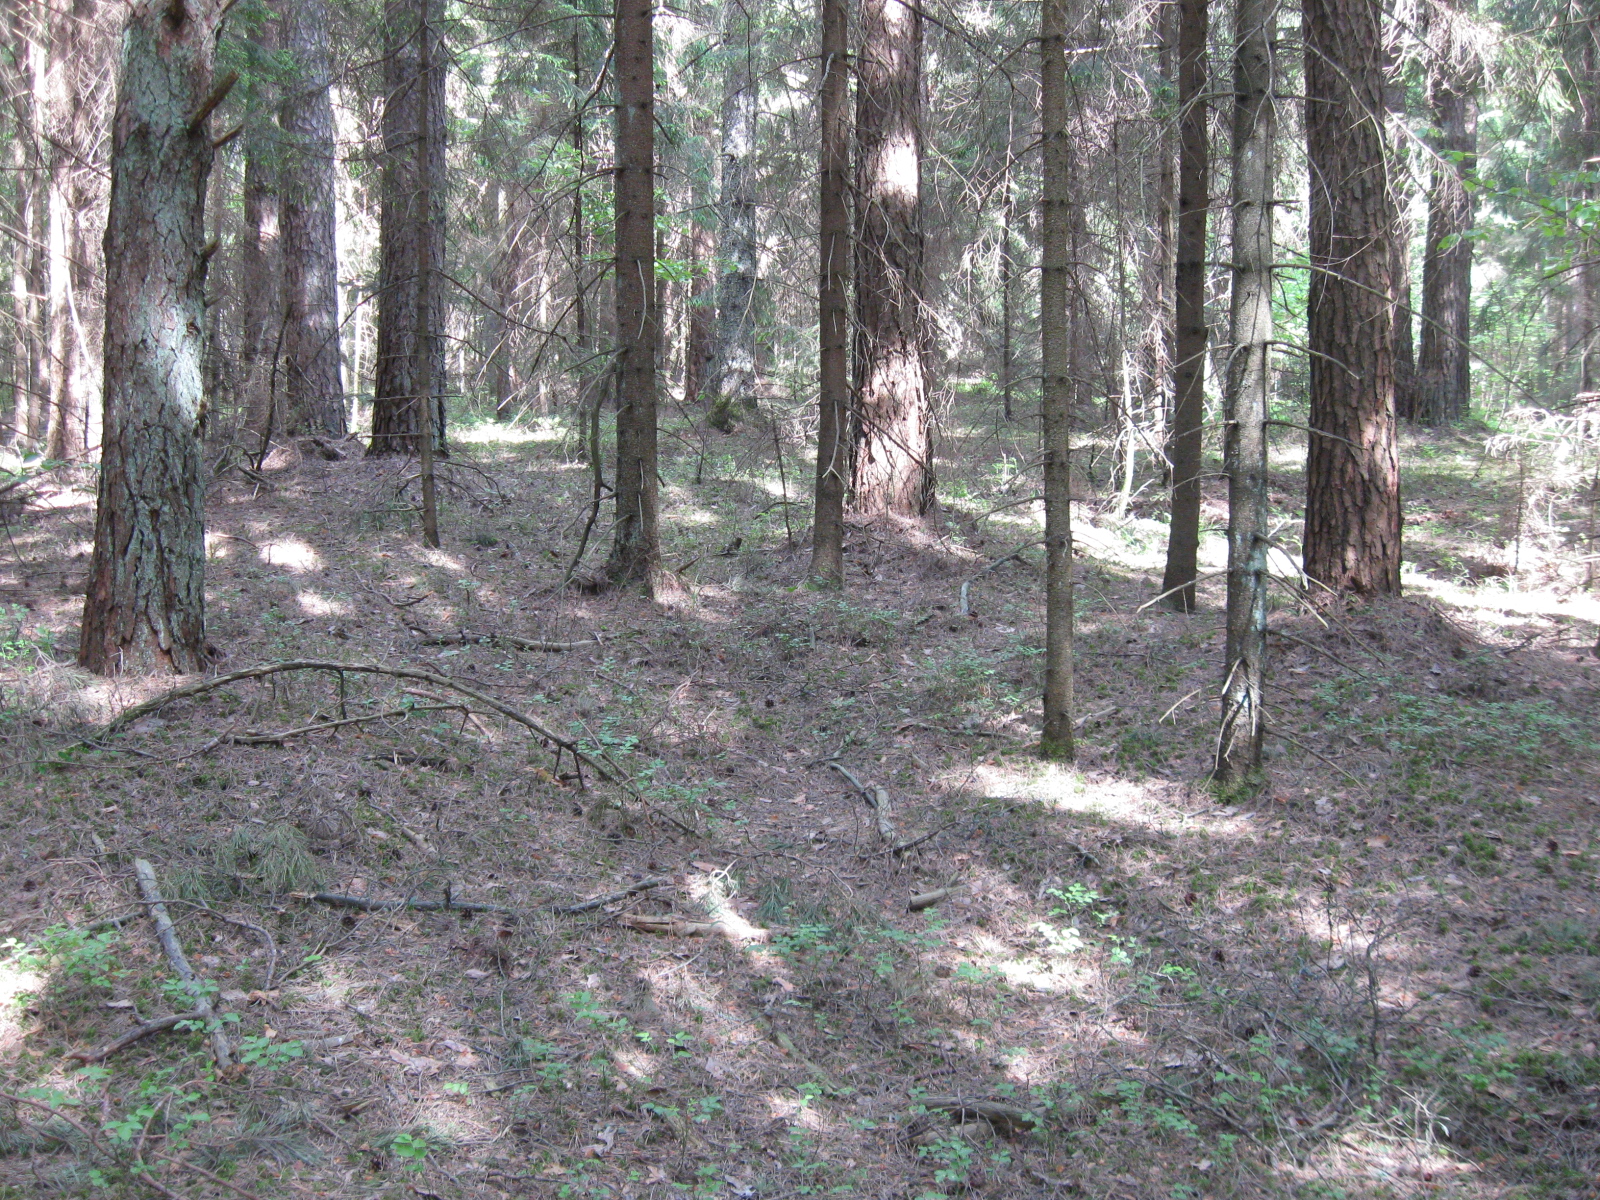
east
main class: Woodland
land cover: Other coniferous woodland
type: hemiboreal forest and nemoral coniferous forest and mixed broadleaved-coniferous forest
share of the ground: > 75 %
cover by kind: coniferous forest trees 100 %
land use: Forestry
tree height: > 5 m
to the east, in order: Other coniferous woodland
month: June
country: LT
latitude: 54.6199
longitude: 23.9198
